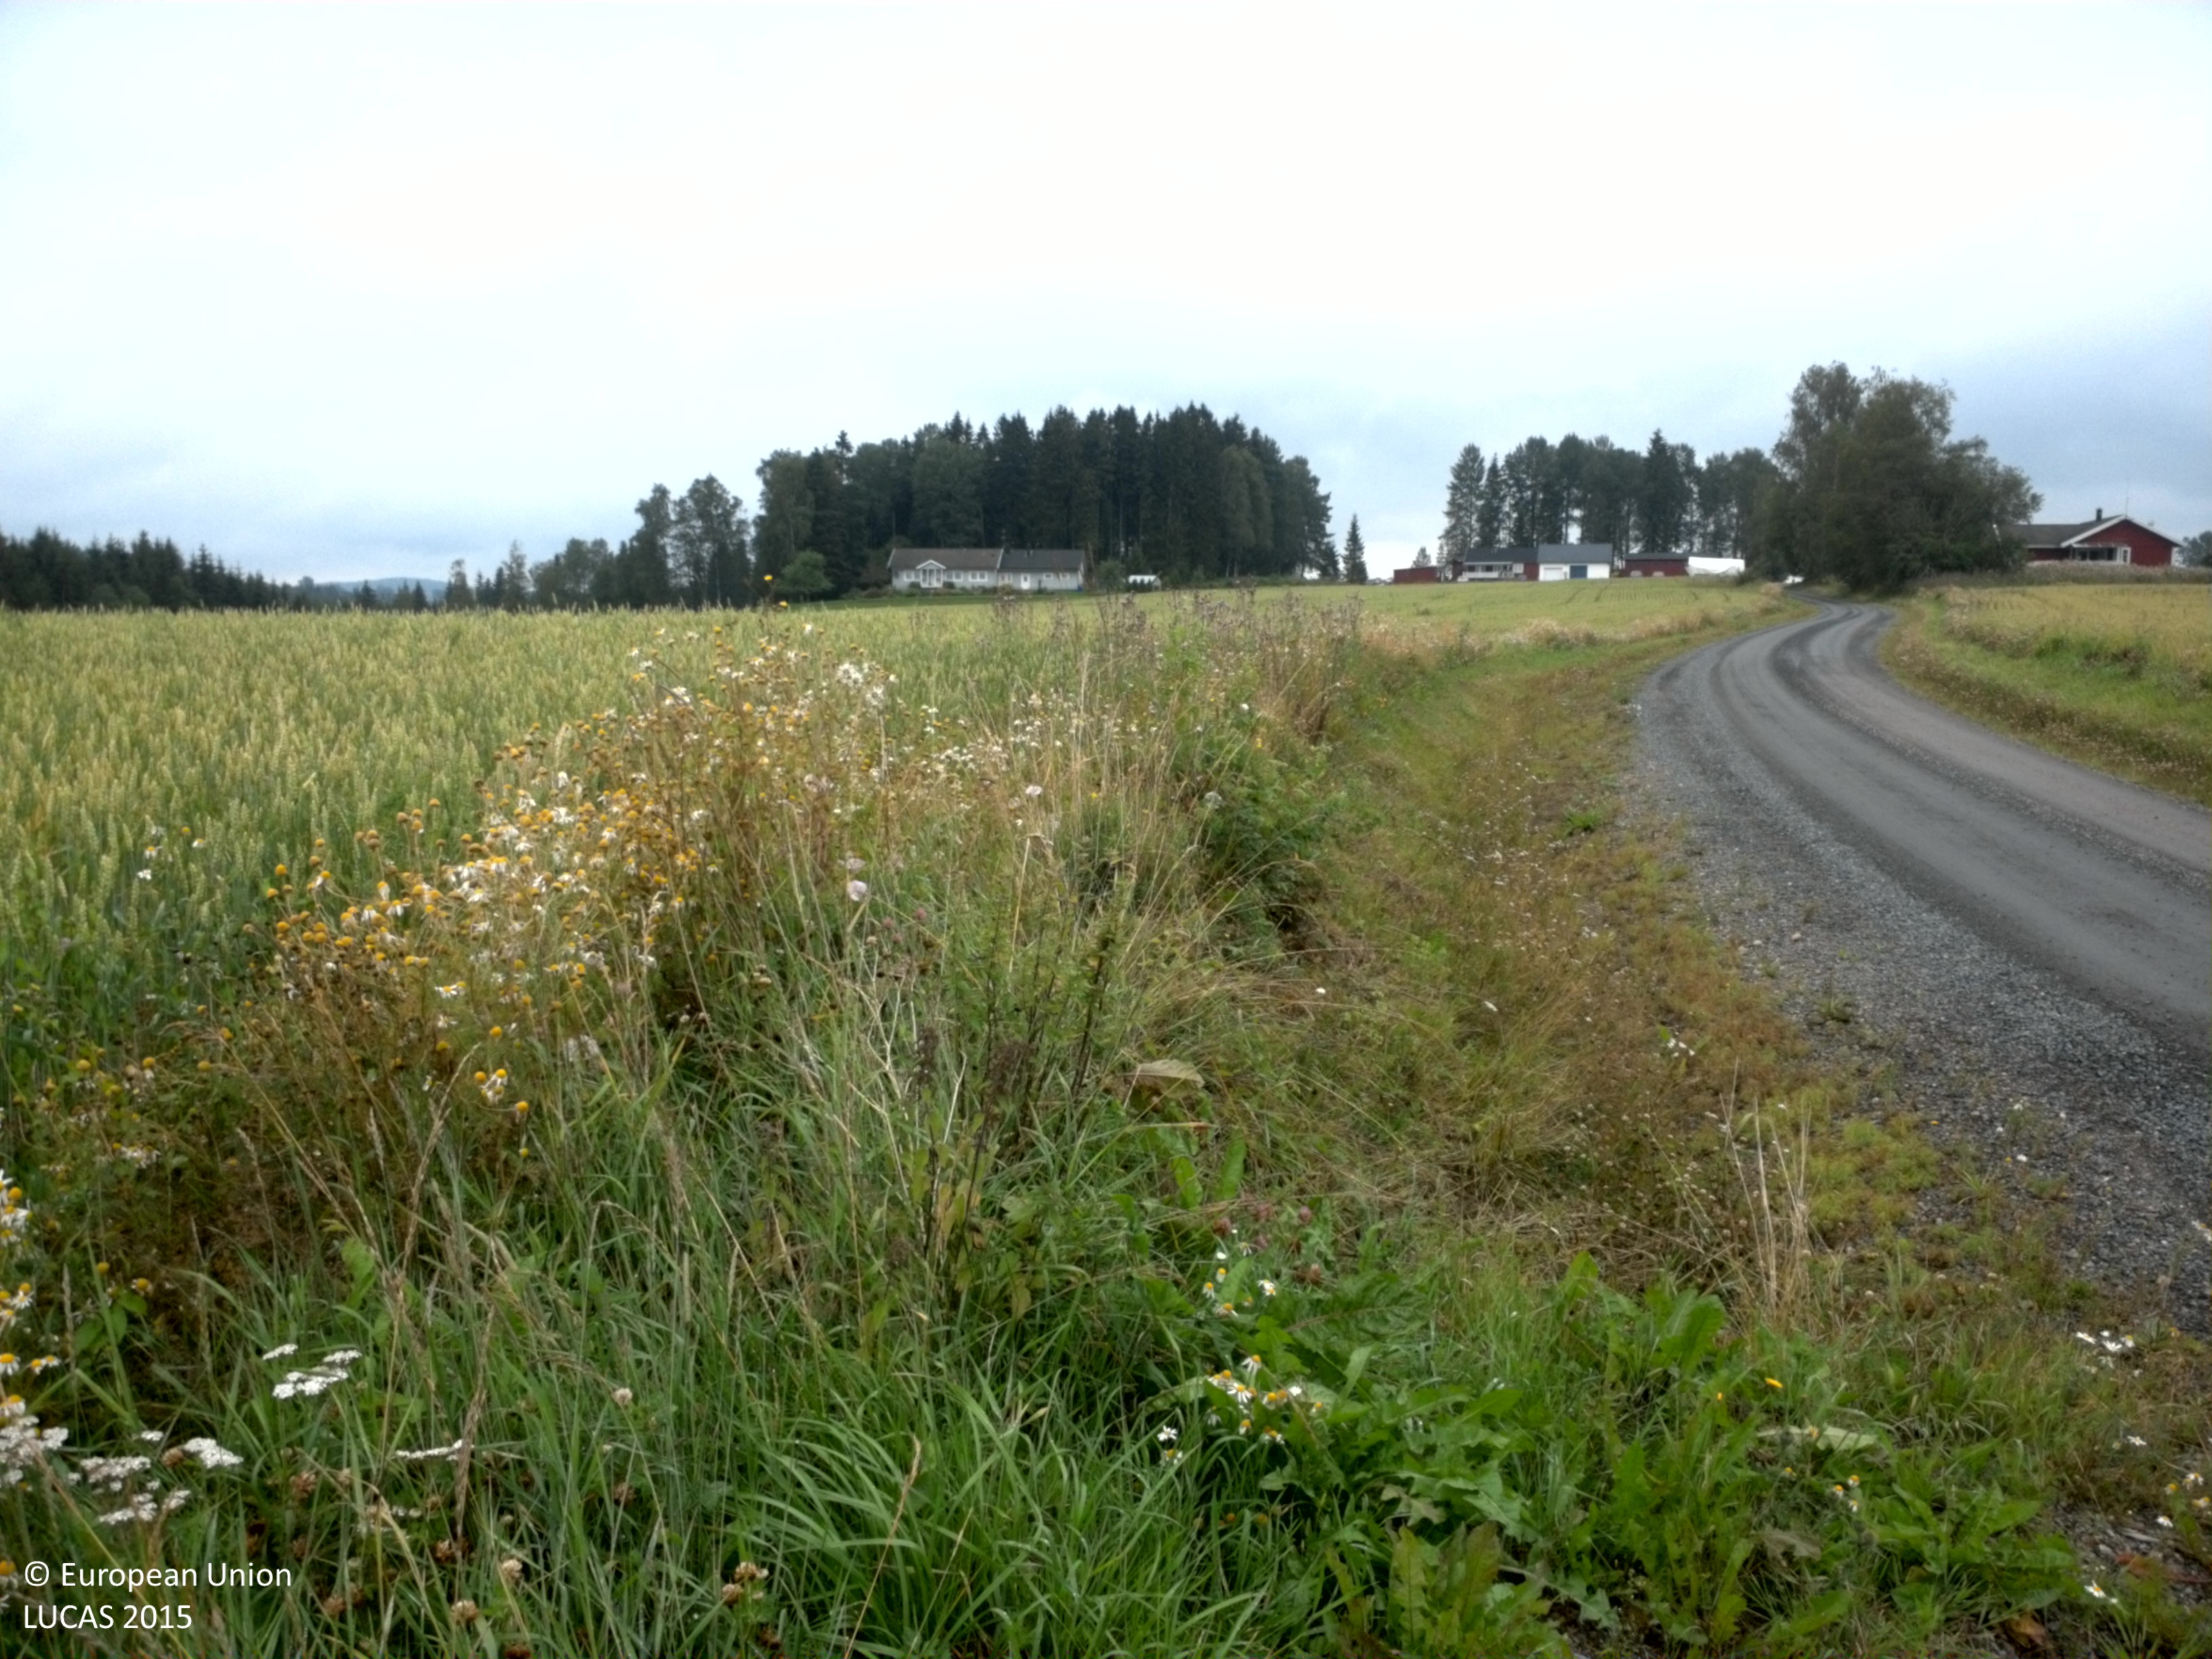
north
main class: Cropland
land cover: Common wheat
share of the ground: > 75 %
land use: Agriculture (excluding fallow land and kitchen gardens)
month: August
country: SE
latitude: 59.4945
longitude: 13.2596
